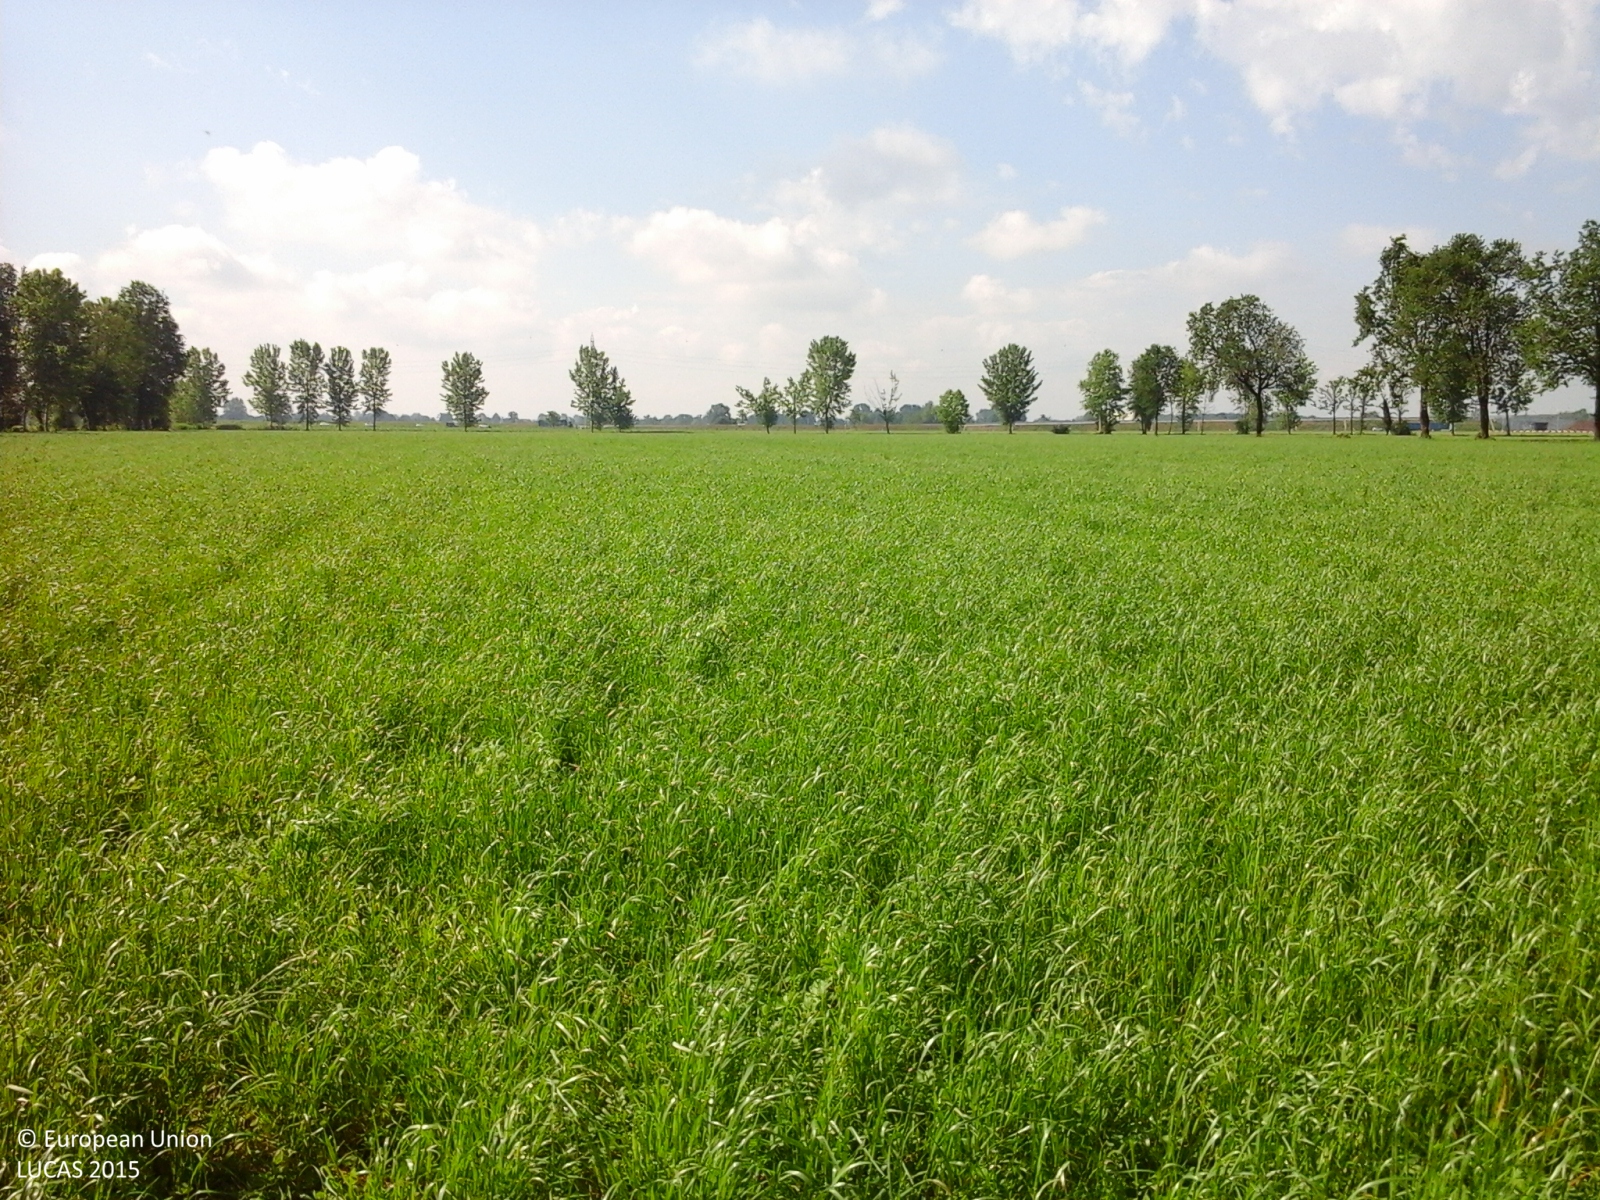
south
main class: Cropland
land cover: Temporary grasslands
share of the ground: > 75 %
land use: Agriculture (excluding fallow land and kitchen gardens)
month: May
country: IT
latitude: 45.3952
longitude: 9.5282
